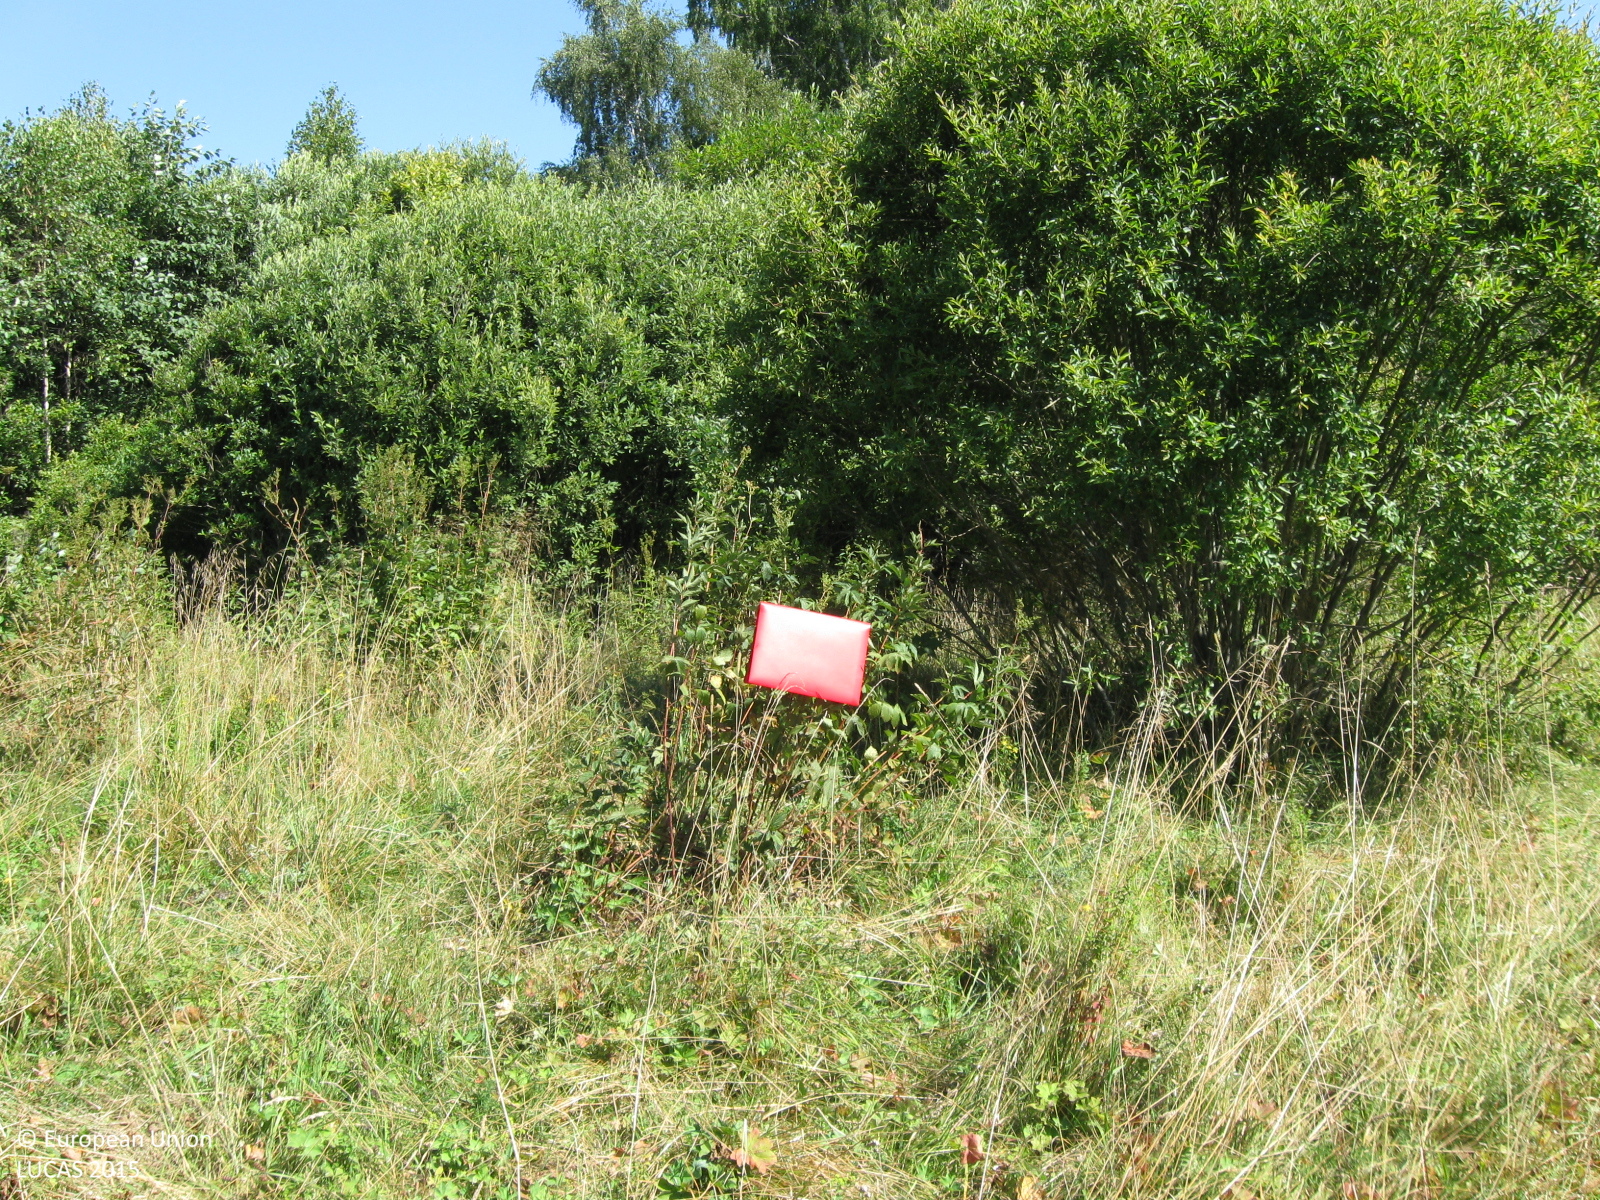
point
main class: Woodland
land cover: Broadleaved woodland
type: non-riverine alder, birch or aspen forest
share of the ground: 25 - 50 %
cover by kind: herbaceous plants 60 %, broadleaved forest trees 30 %, shrubs 10 %
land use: Forestry
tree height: < 5 m
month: August
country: LT
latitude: 55.3865
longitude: 22.5483
